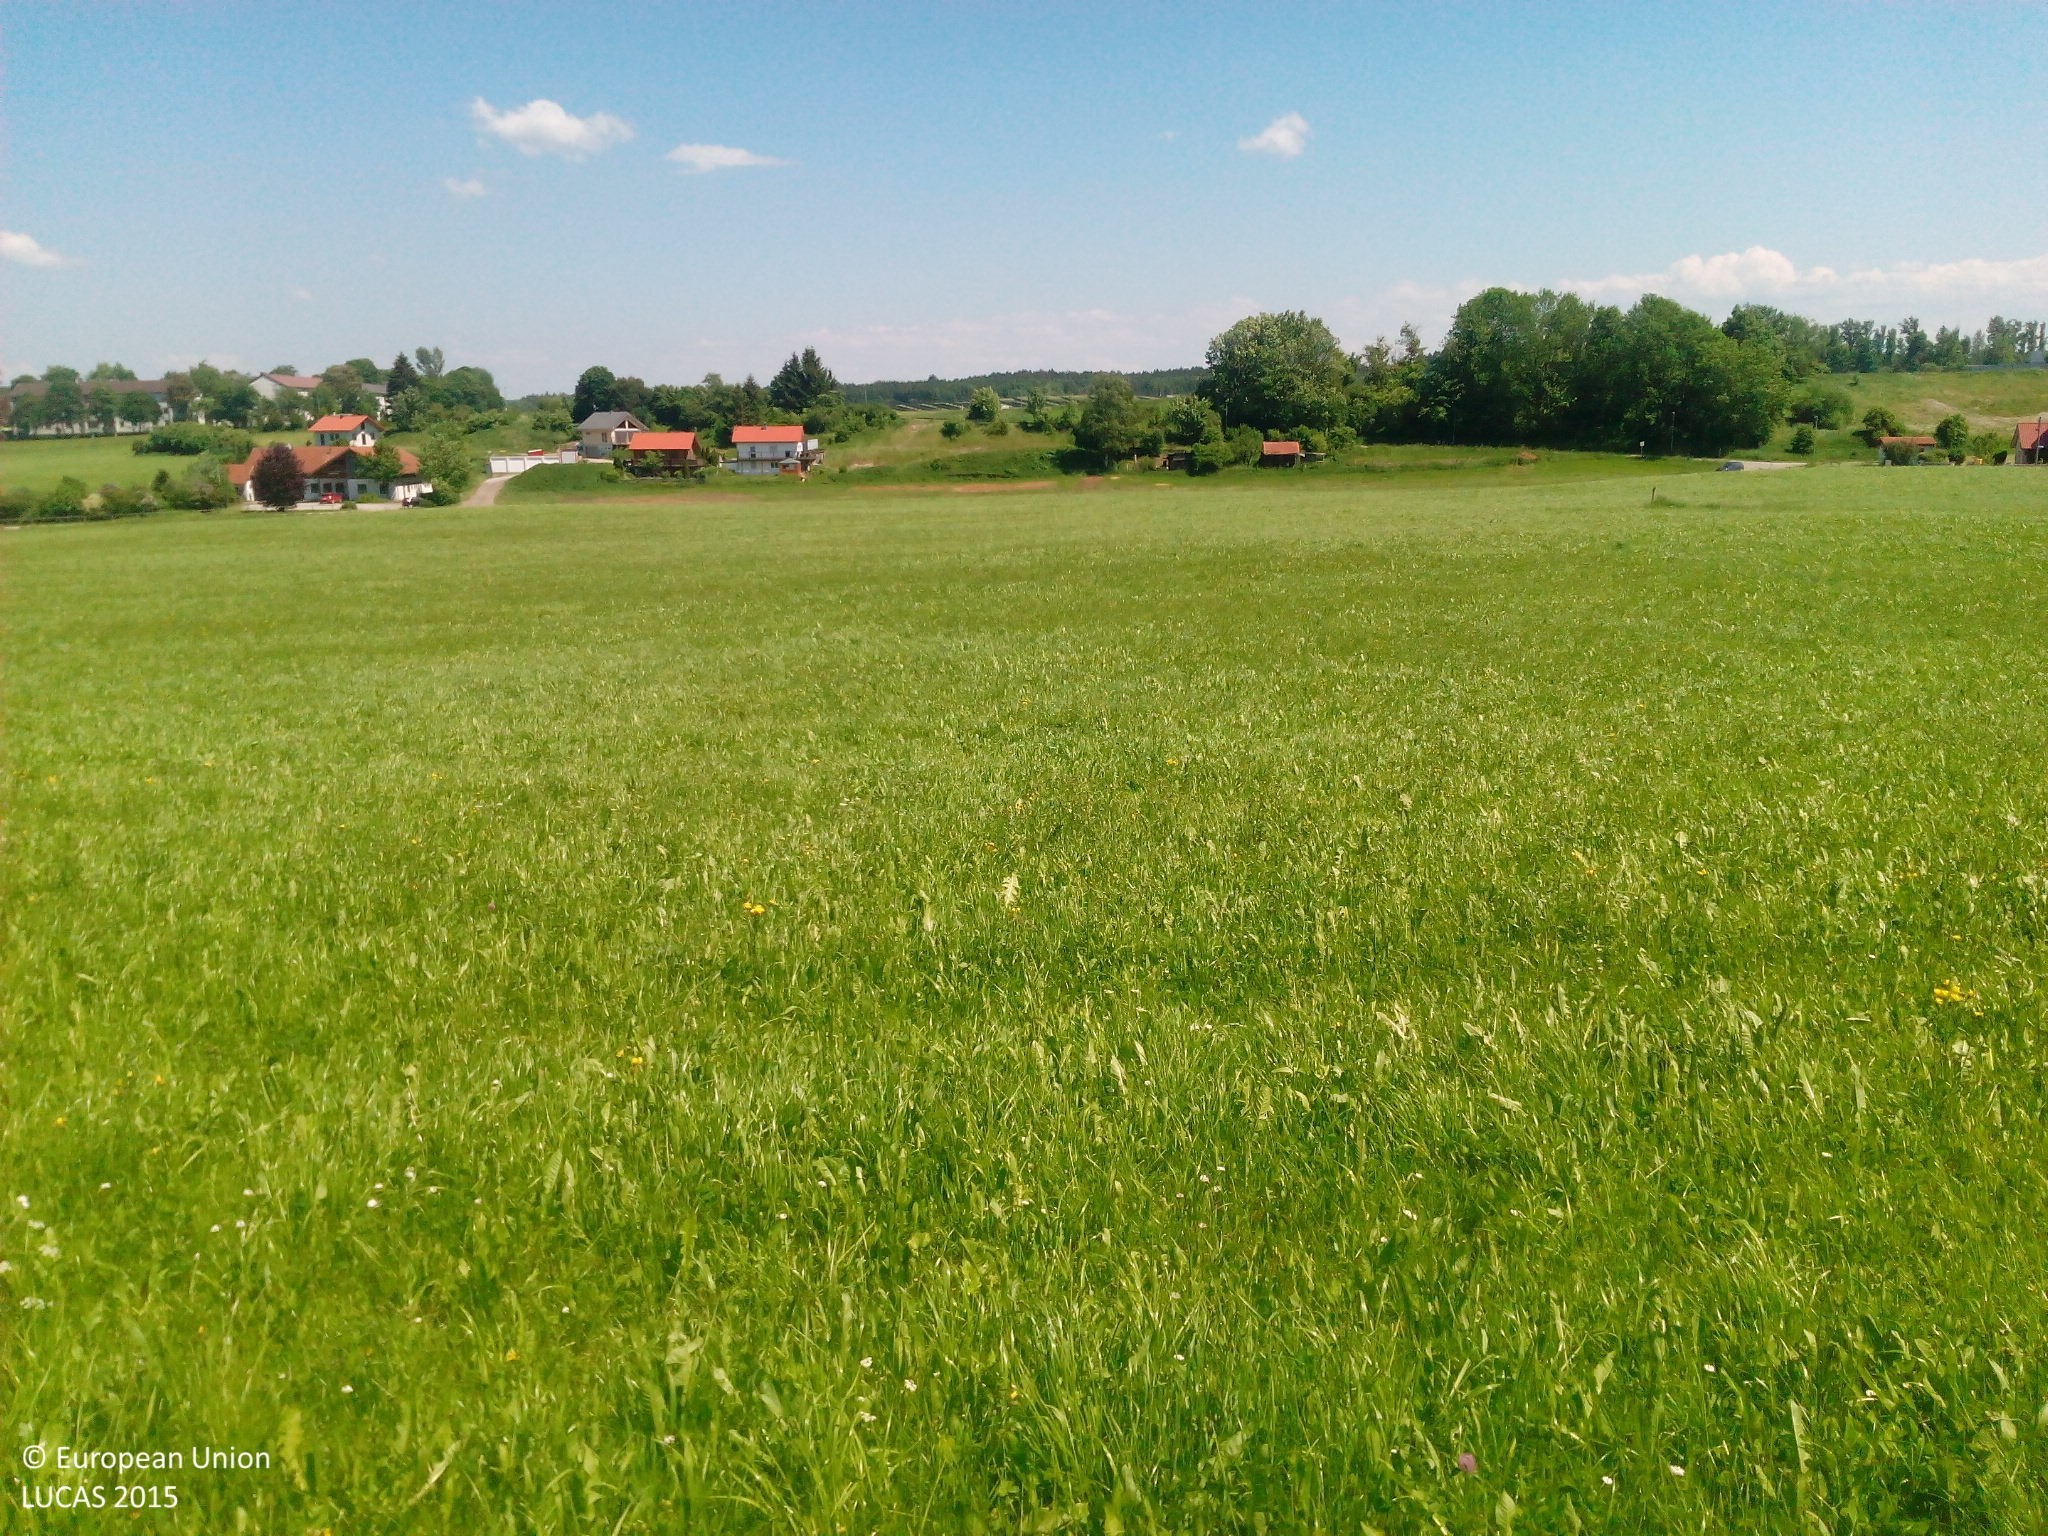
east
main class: Grassland
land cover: Grassland without tree/shrub cover
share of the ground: > 75 %
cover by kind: herbaceous plants 100 %
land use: Agriculture (excluding fallow land and kitchen gardens)
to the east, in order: Grassland without tree/shrub cover; Rivers and streams; Artificial constructions in urban areas
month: June
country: DE
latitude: 47.8620
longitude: 10.6011
